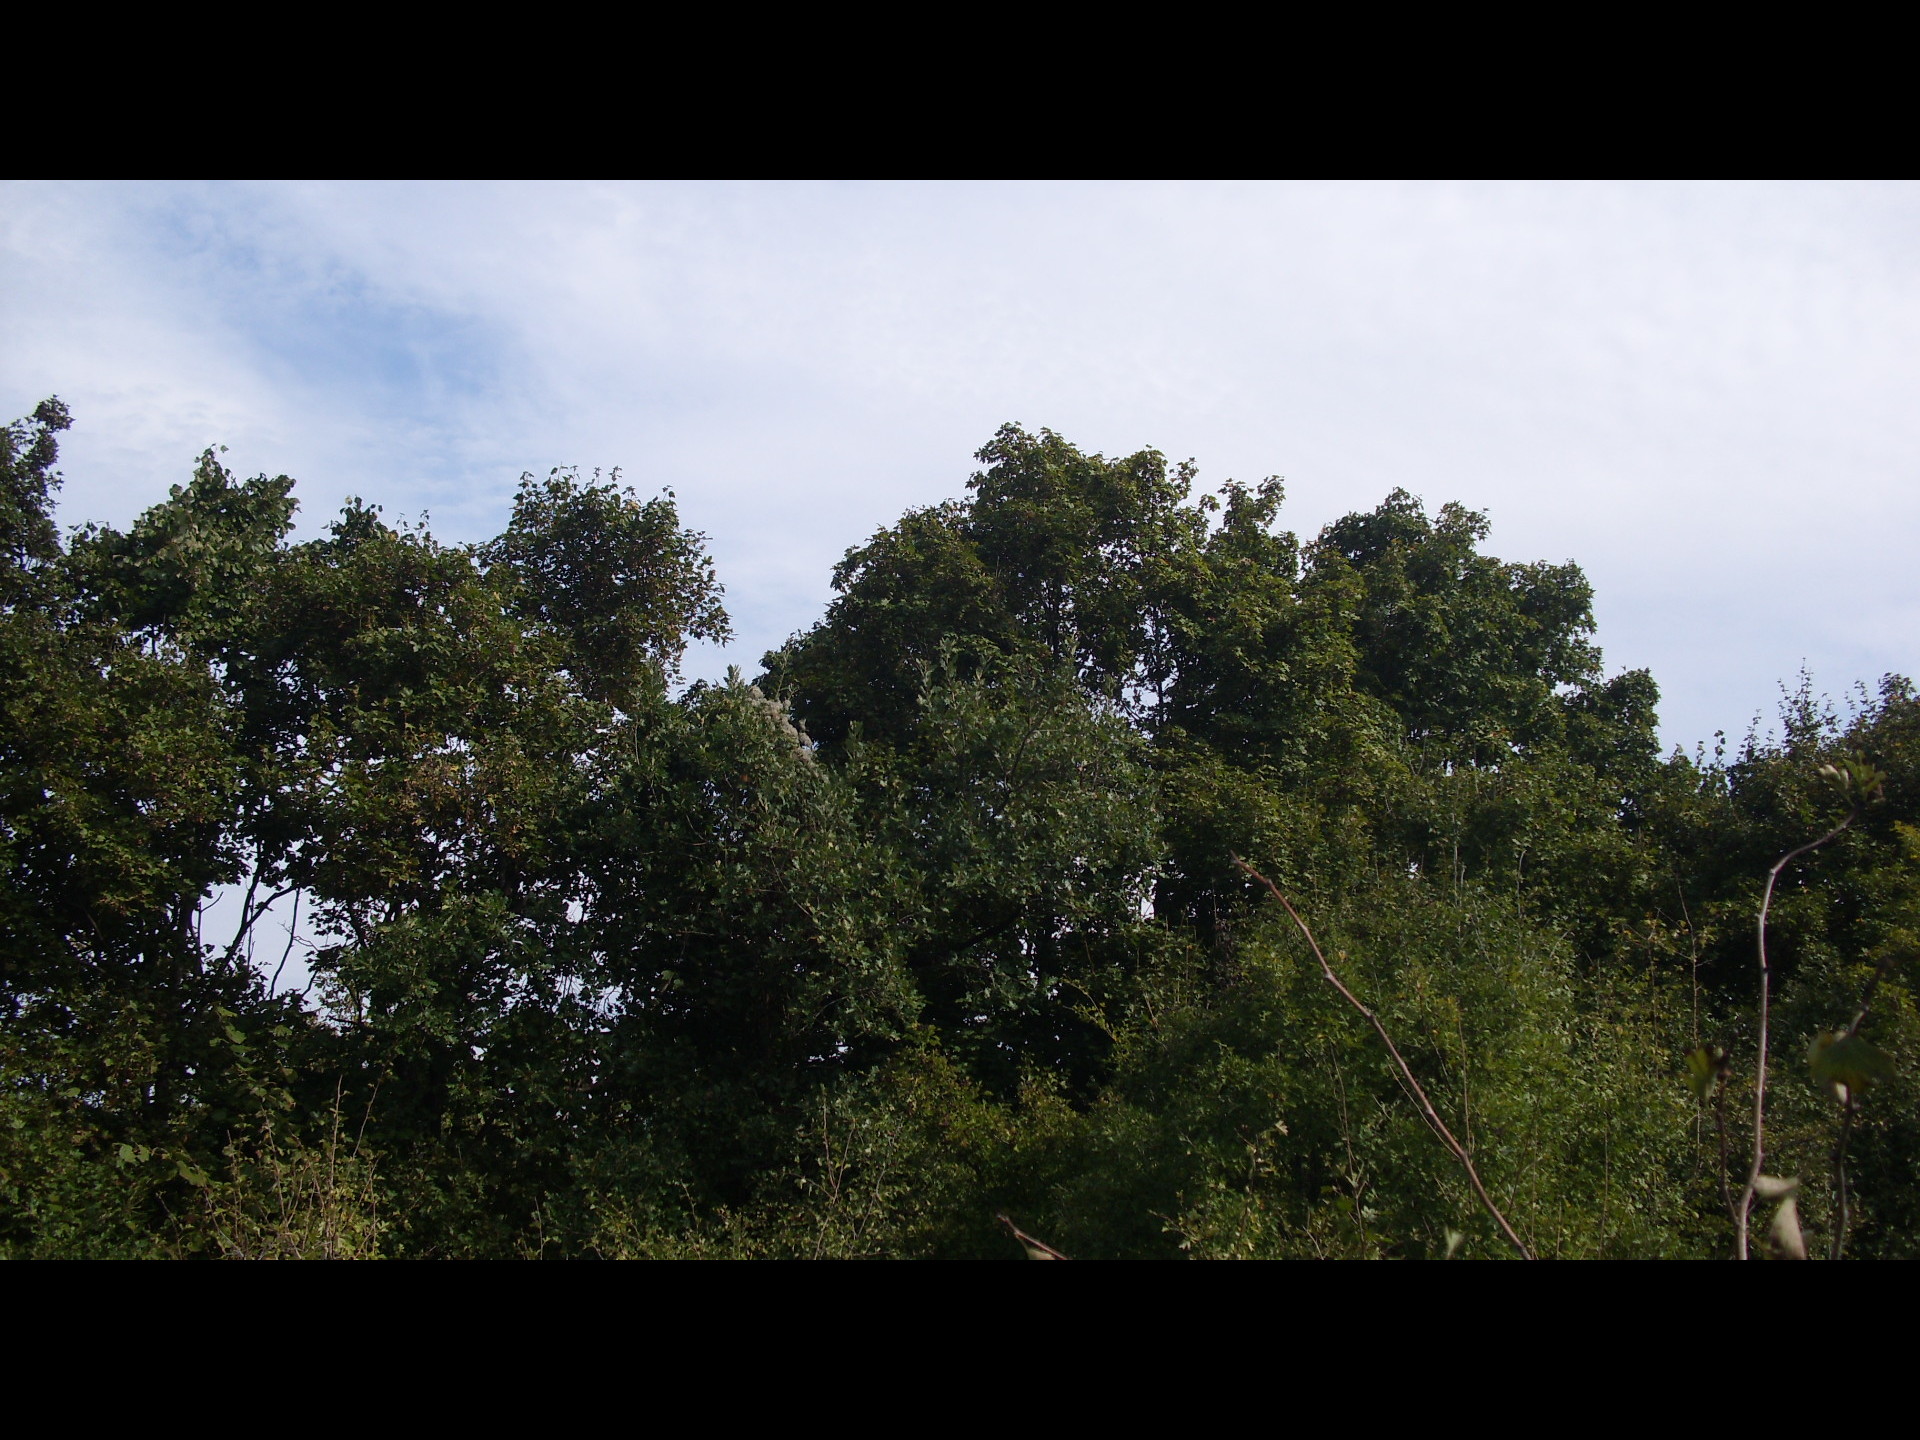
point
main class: Woodland
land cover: Broadleaved woodland
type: mesophytic deciduous forest
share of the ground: > 75 %
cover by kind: broadleaved forest trees 95 %, shrubs 5 %
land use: Forestry
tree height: > 5 m
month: October
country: BG
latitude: 43.8898
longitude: 22.5947
